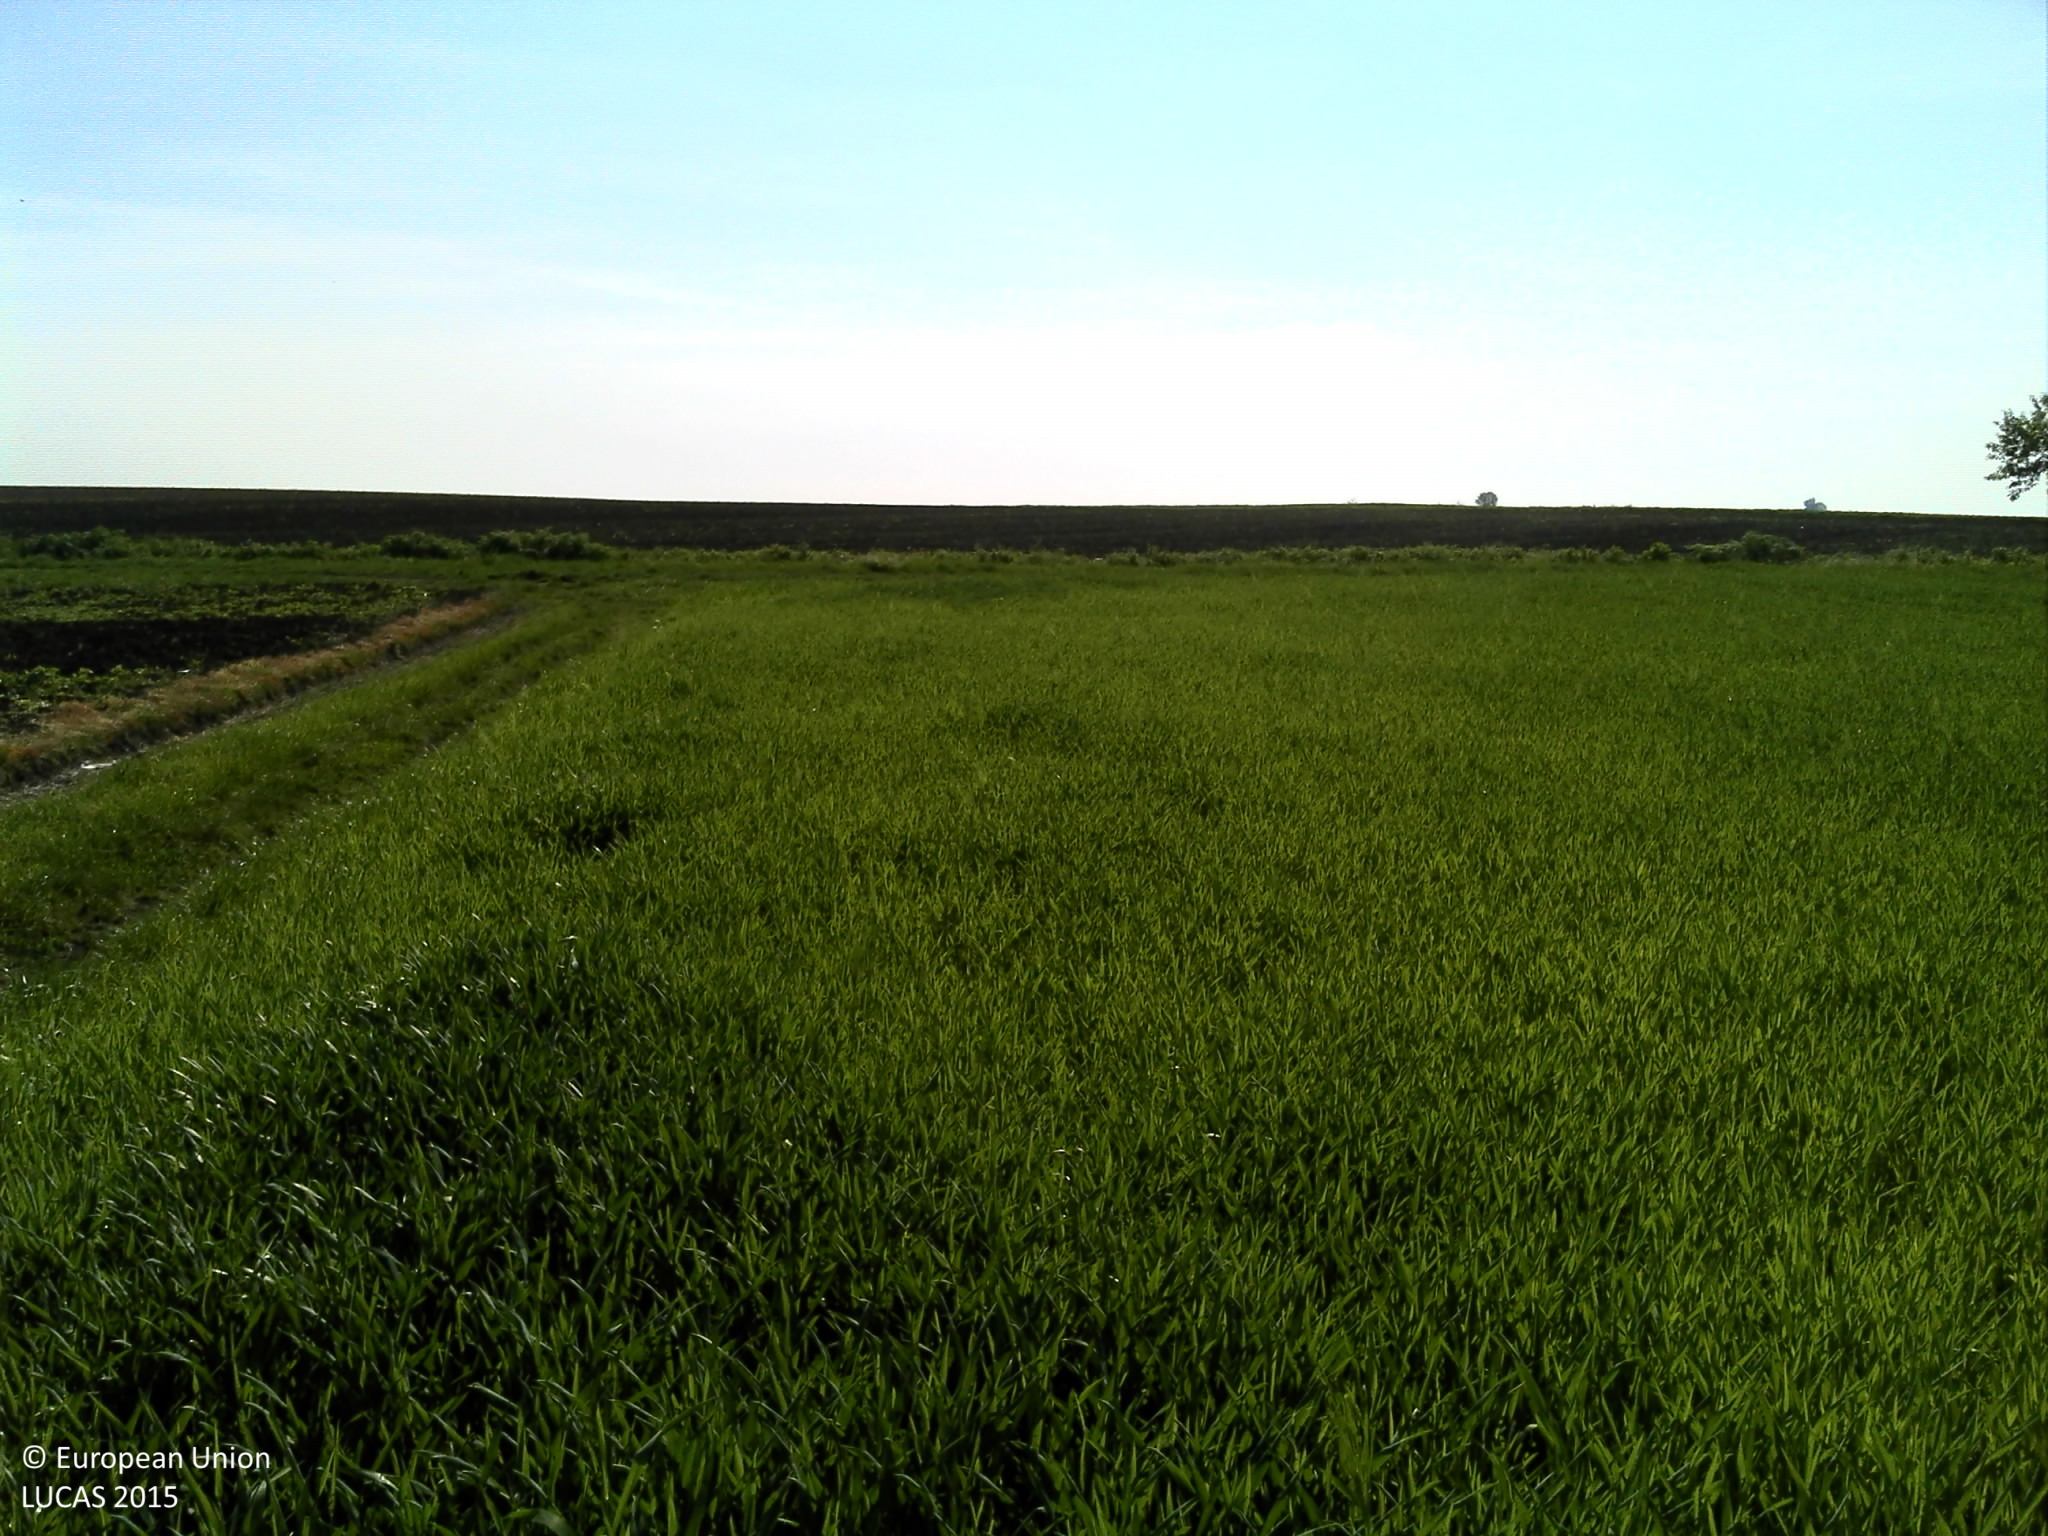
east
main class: Cropland
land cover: Common wheat
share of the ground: > 75 %
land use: Agriculture (excluding fallow land and kitchen gardens)
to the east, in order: Common wheat; Tracks; Ditches and canals; Soya; Tracks; Arable land (only in case pi)
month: May
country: HR
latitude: 45.4545
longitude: 18.8958
